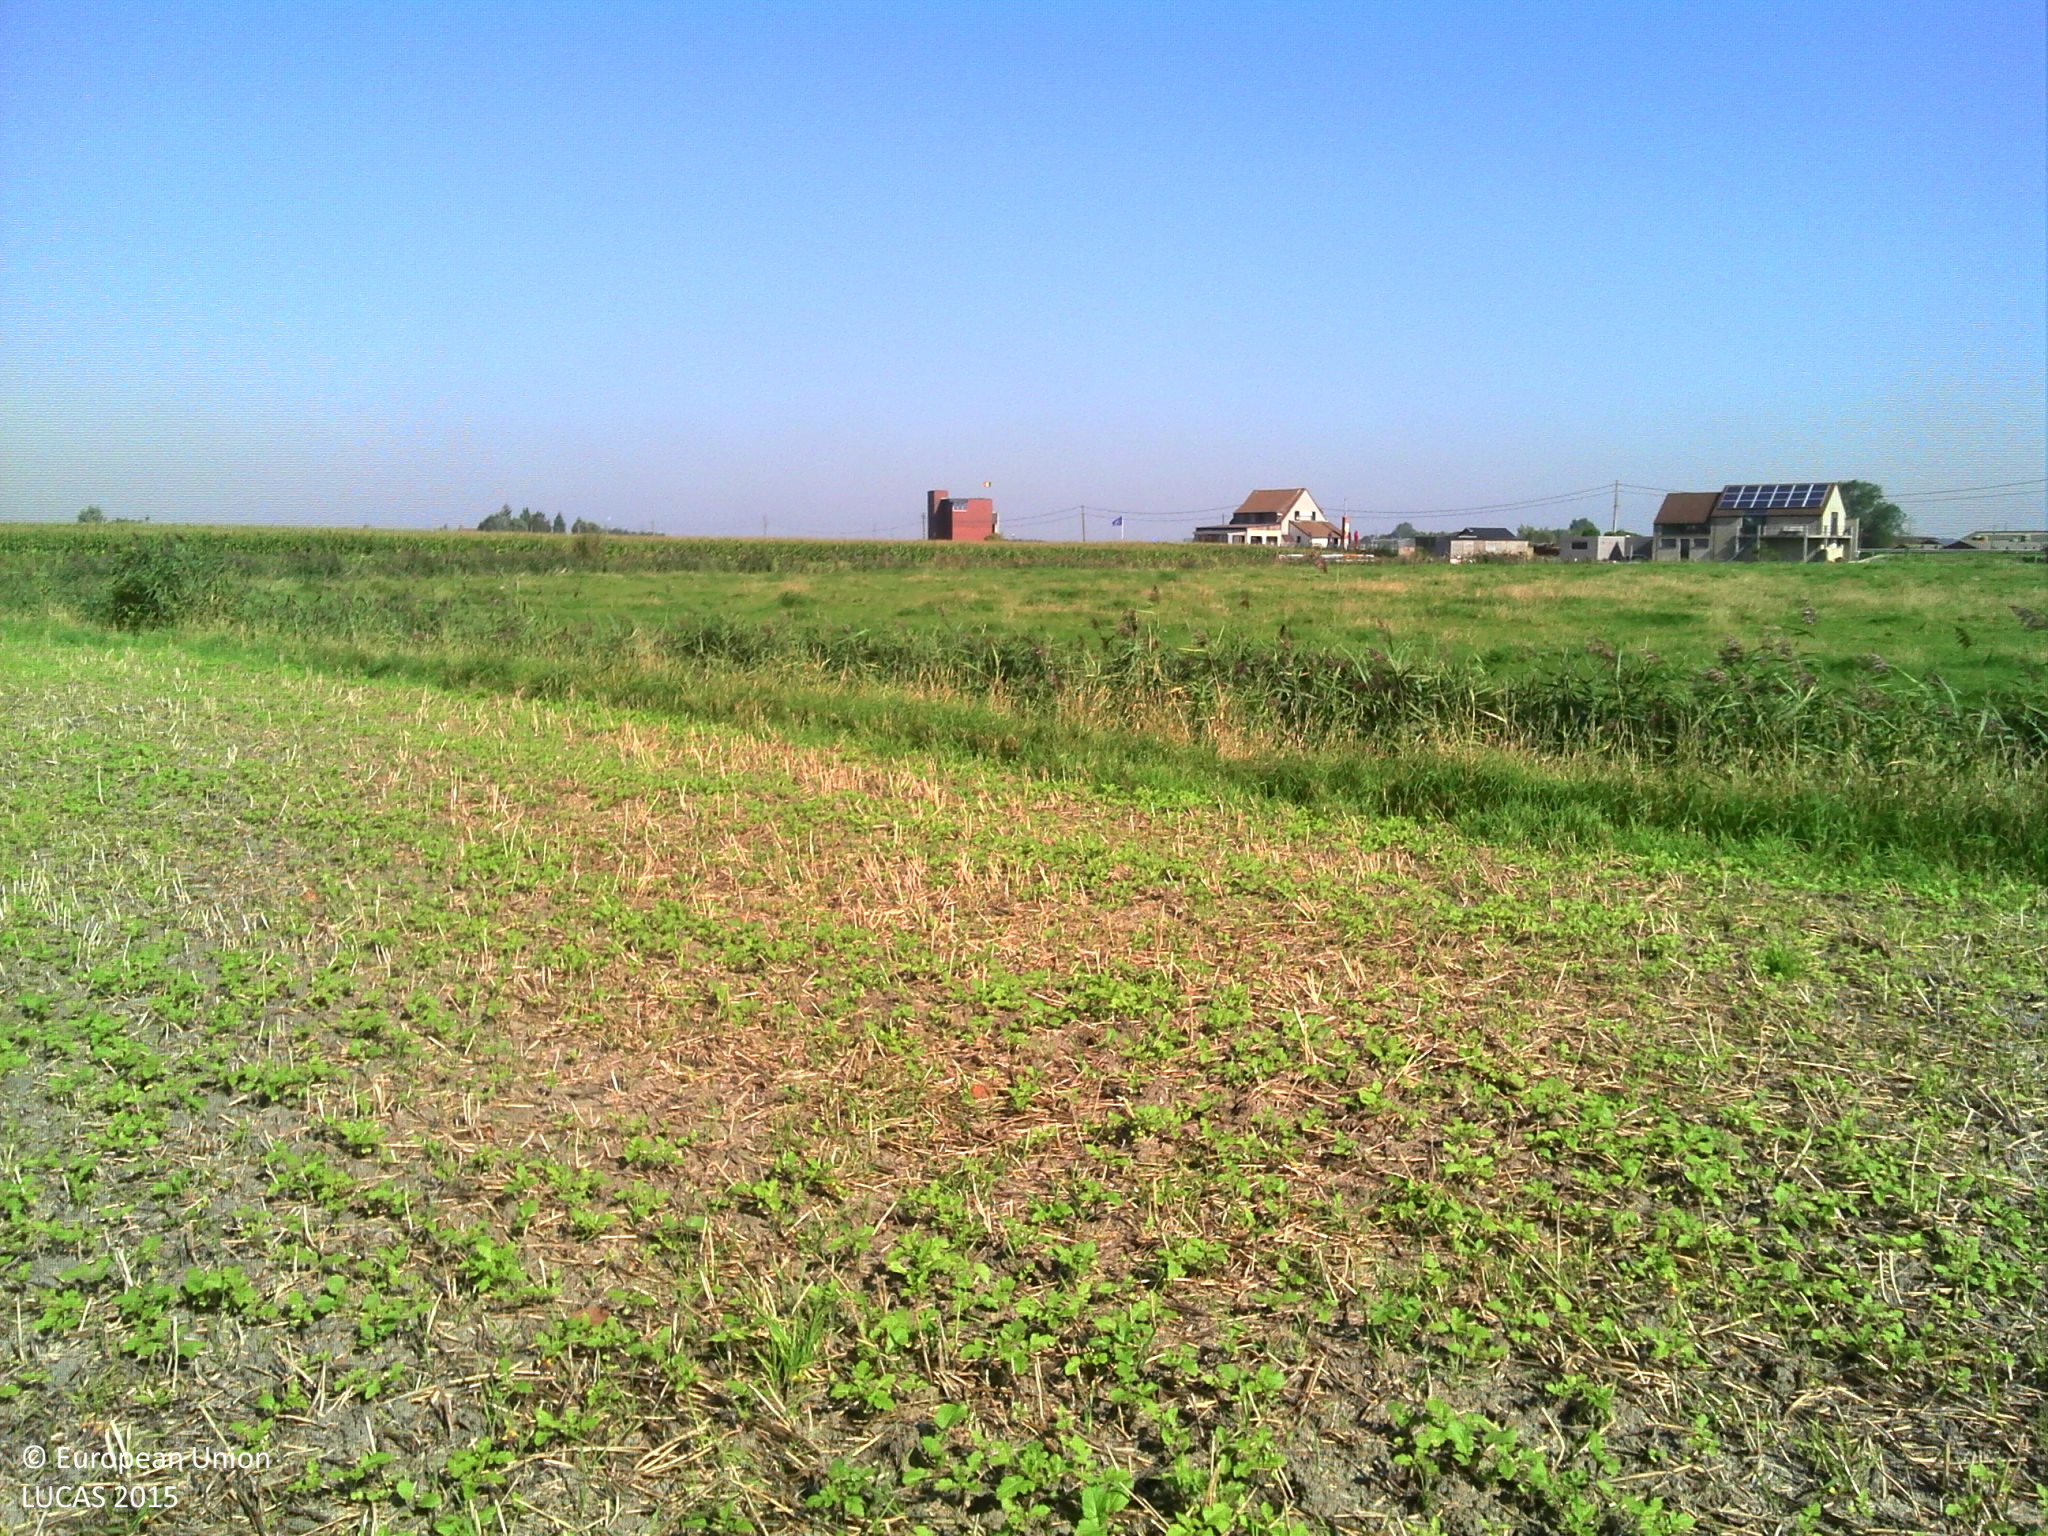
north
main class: Cropland
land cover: Other fibre and oleaginous crops
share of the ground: 50 - 75 %
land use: Agriculture (excluding fallow land and kitchen gardens)
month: September
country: BE
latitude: 51.0424
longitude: 2.8434
